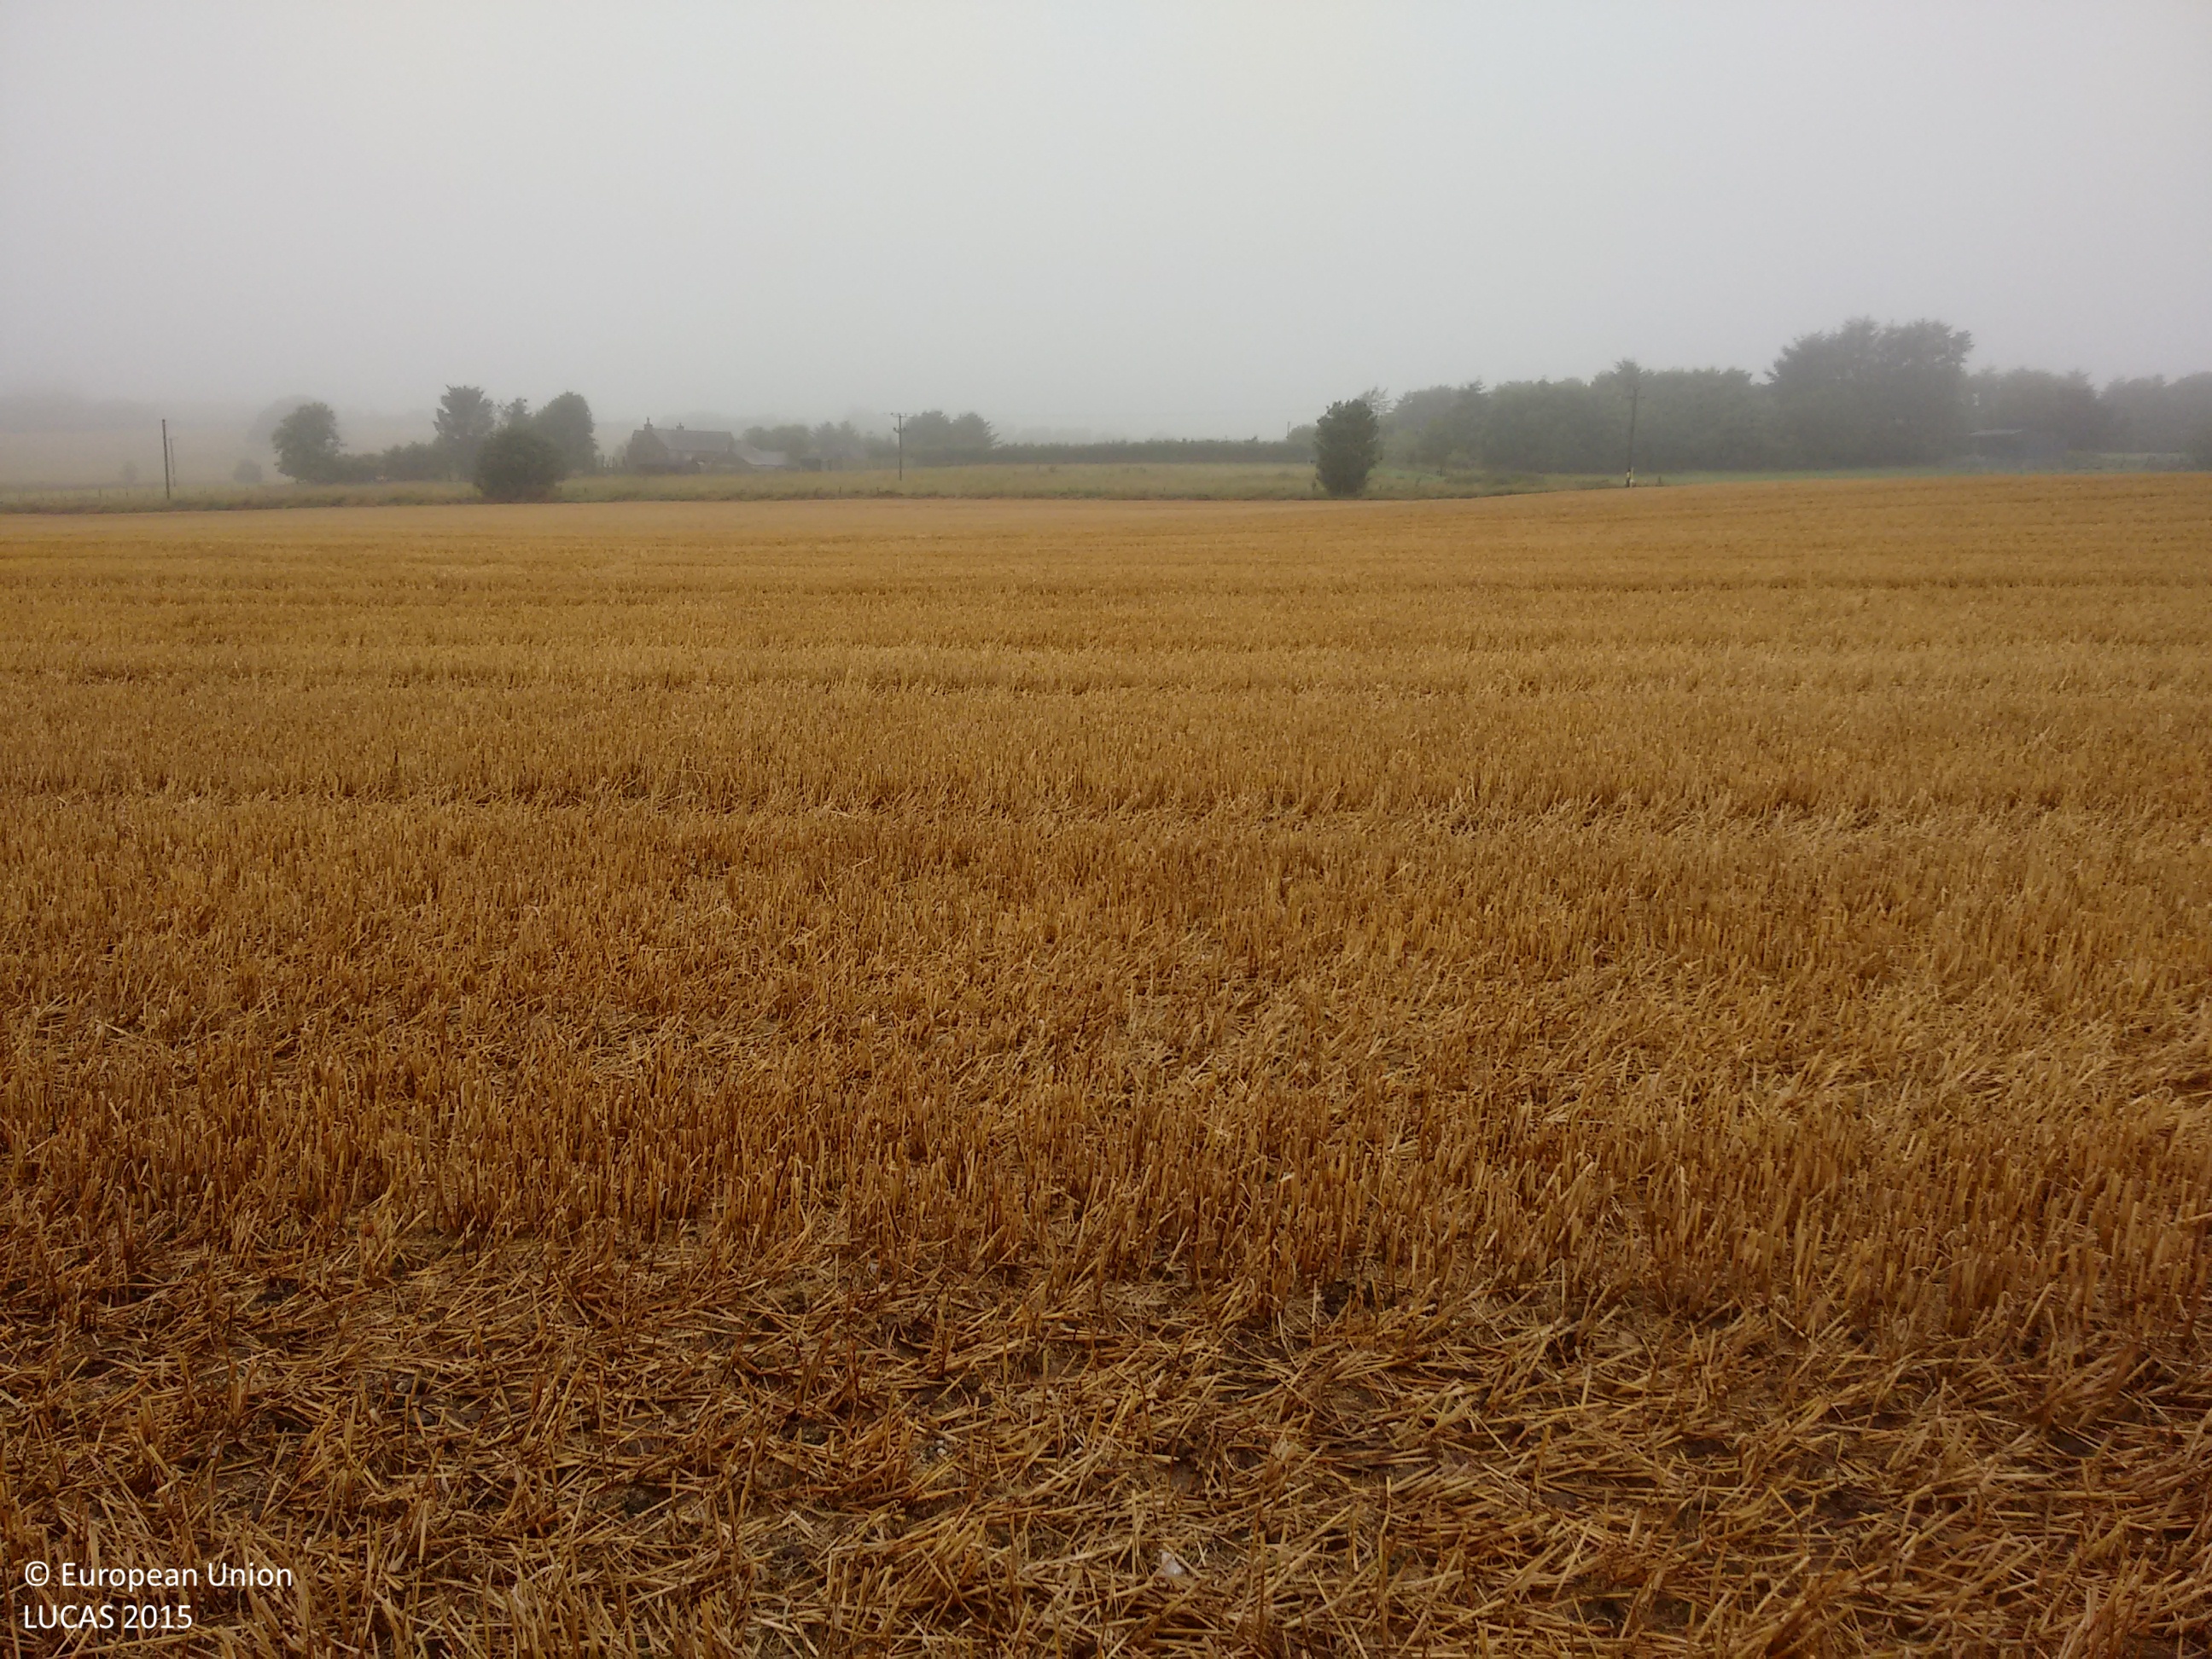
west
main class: Cropland
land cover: Barley
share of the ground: > 75 %
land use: Agriculture (excluding fallow land and kitchen gardens)
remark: Harvested field
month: August
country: GB
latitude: 57.4107
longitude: -2.1498
